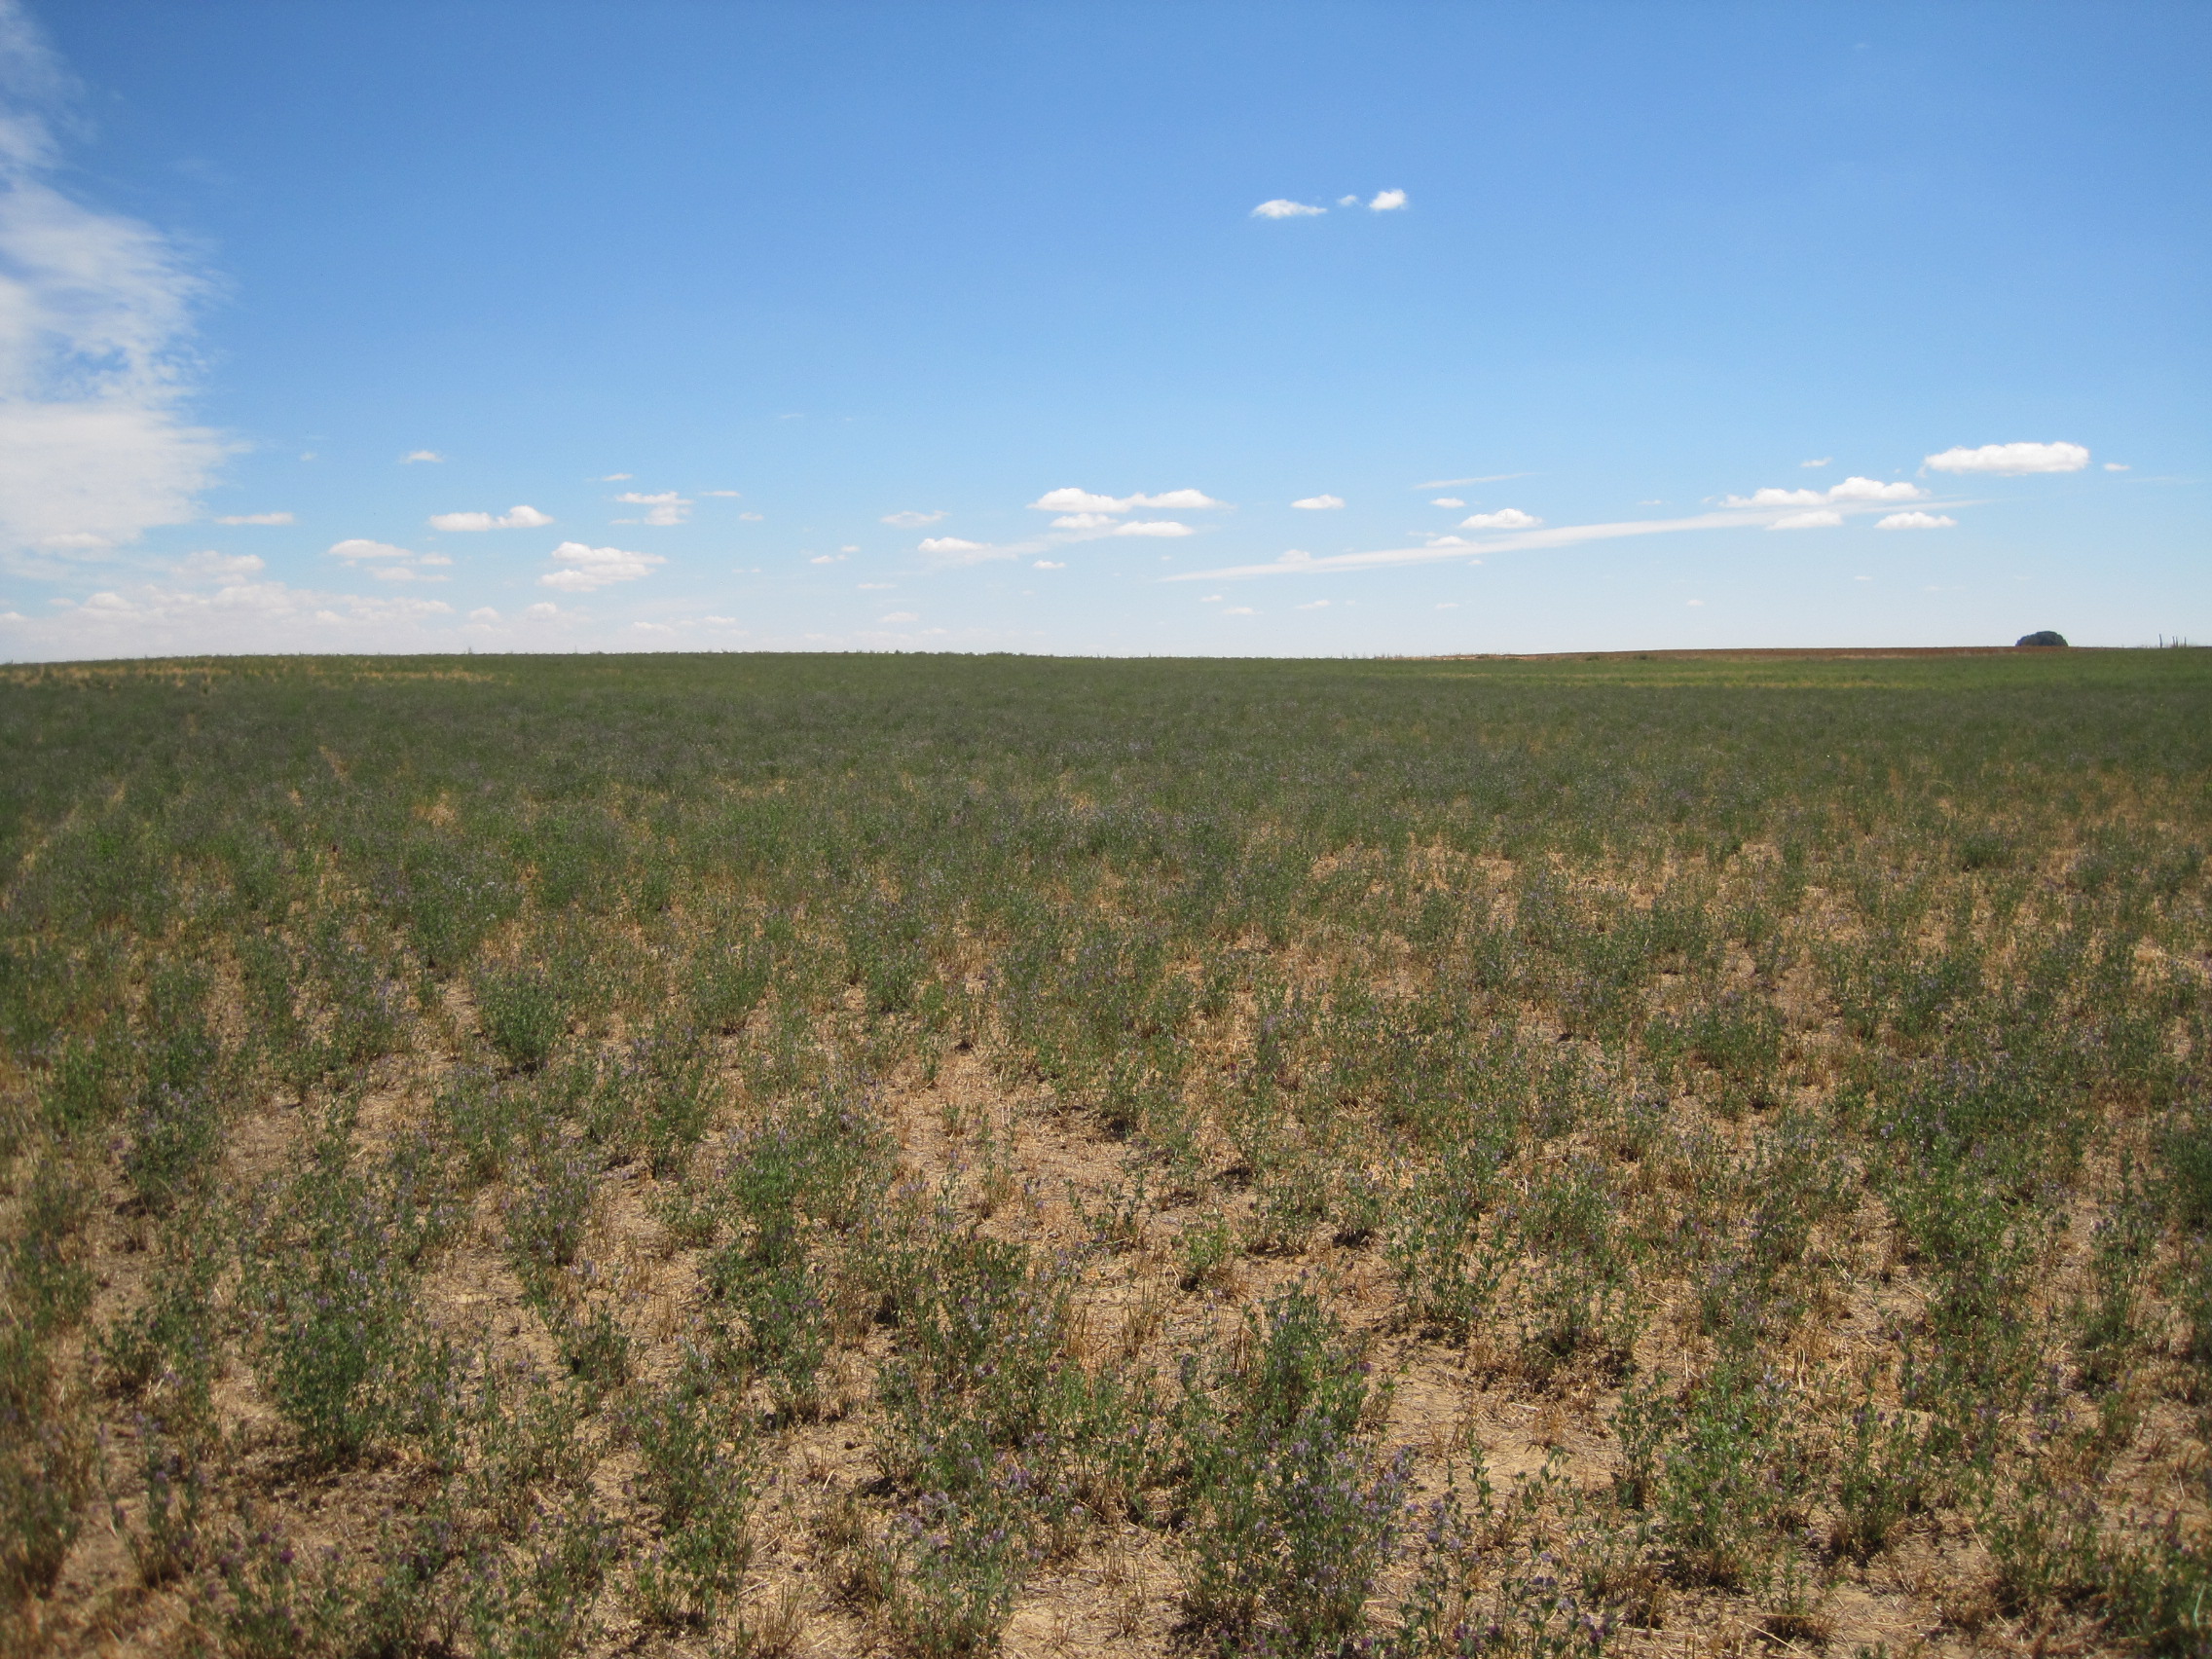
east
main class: Cropland
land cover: Lucerne
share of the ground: > 75 %
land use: Agriculture (excluding fallow land and kitchen gardens)
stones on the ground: < 10 %
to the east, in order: Lucerne; Grass margins; Other bare soil
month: July
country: ES
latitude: 41.9911
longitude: -5.5768
